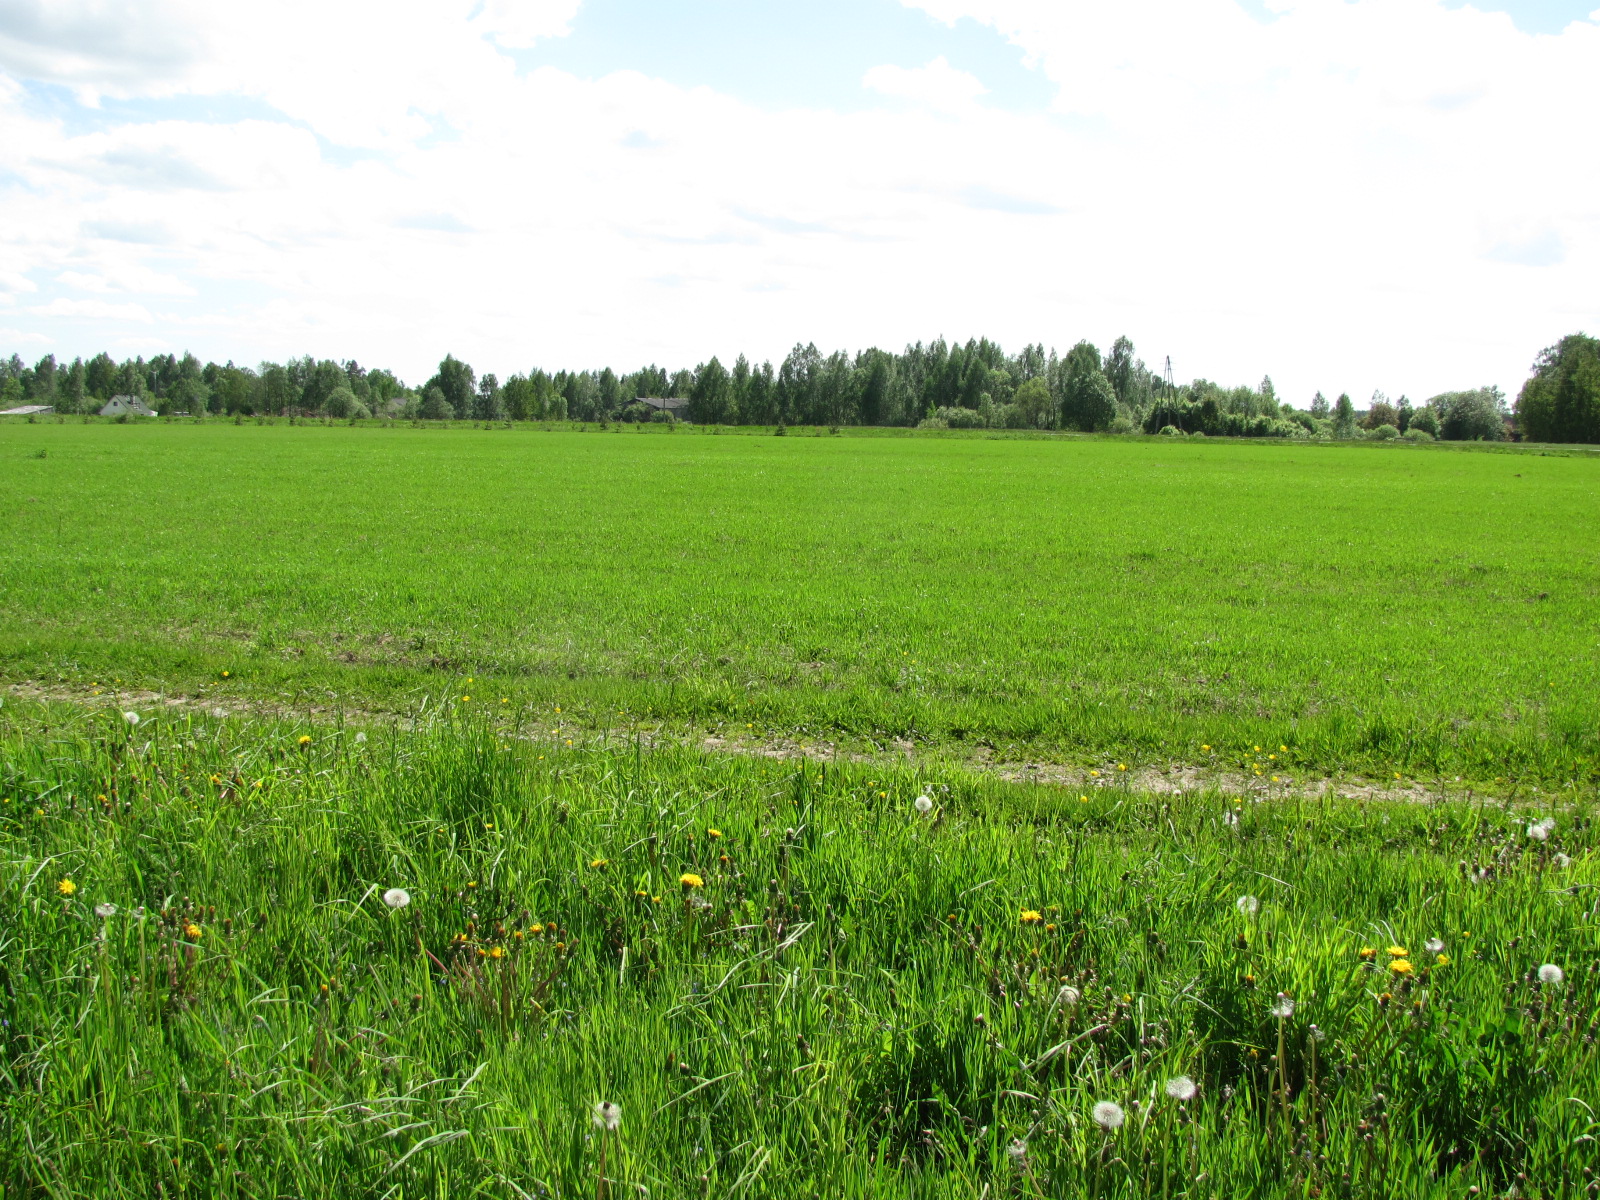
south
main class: Grassland
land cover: Grassland without tree/shrub cover
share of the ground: > 75 %
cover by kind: herbaceous plants 100 %
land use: Agriculture (excluding fallow land and kitchen gardens)
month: May
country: LV
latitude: 56.6267
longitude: 23.9547
